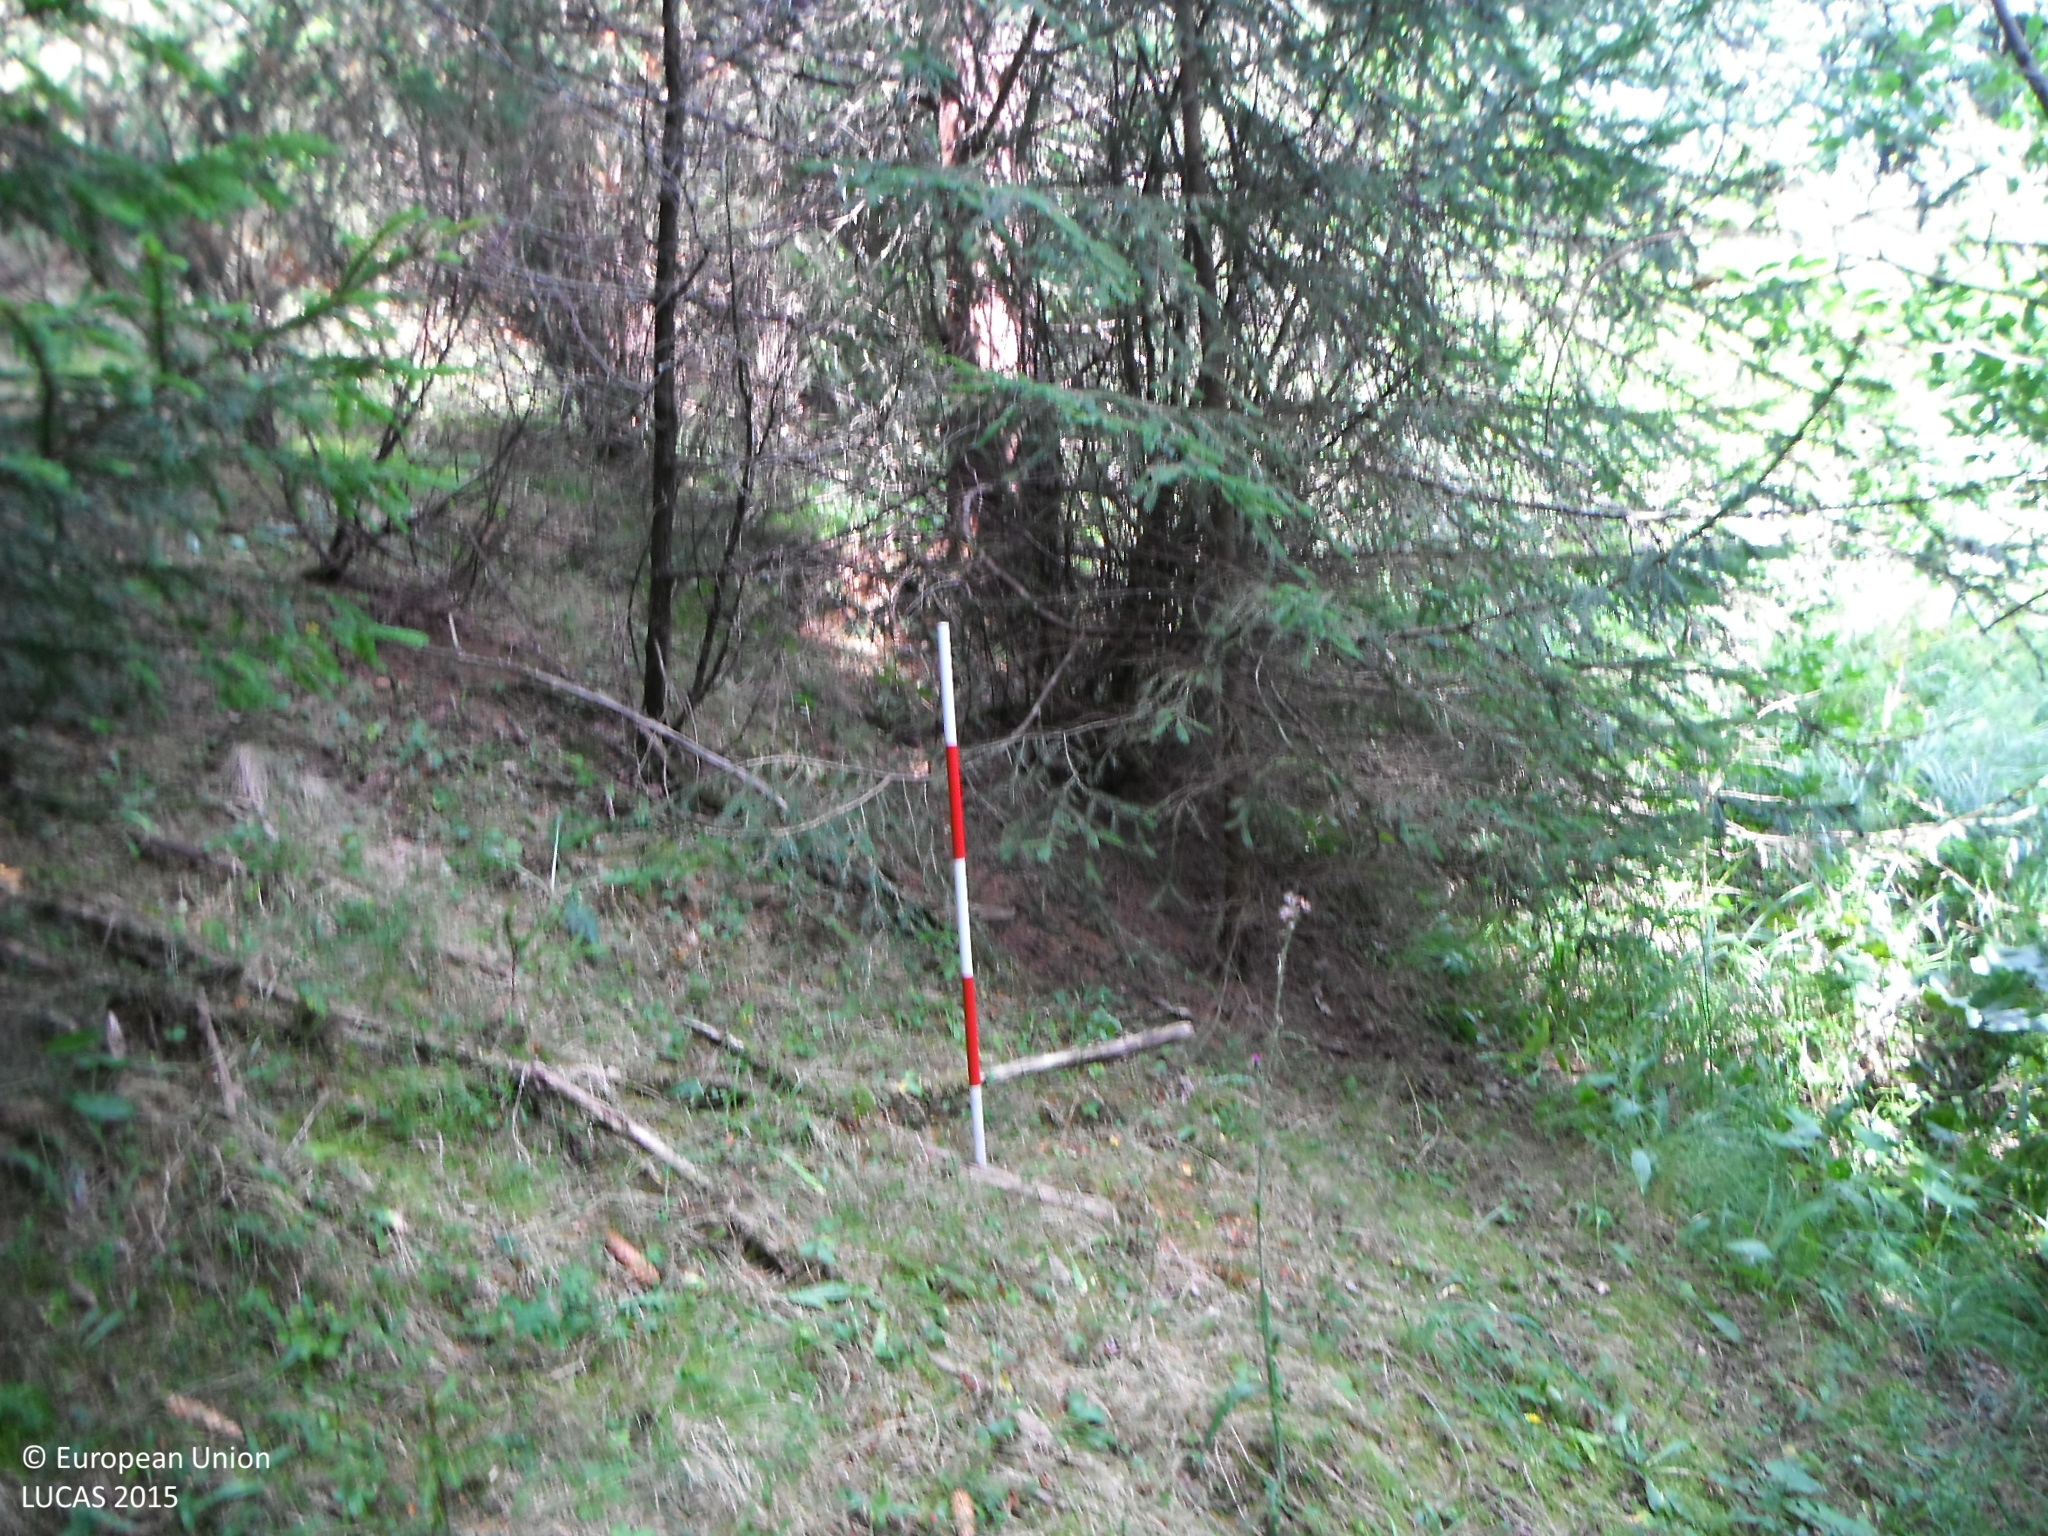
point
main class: Woodland
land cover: Spruce dominated coniferous woodland
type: alpine coniferous forest
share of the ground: > 75 %
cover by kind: coniferous forest trees 100 %
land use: Forestry
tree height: > 5 m
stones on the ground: > 50 %
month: August
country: SK
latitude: 48.8413
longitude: 20.1558
